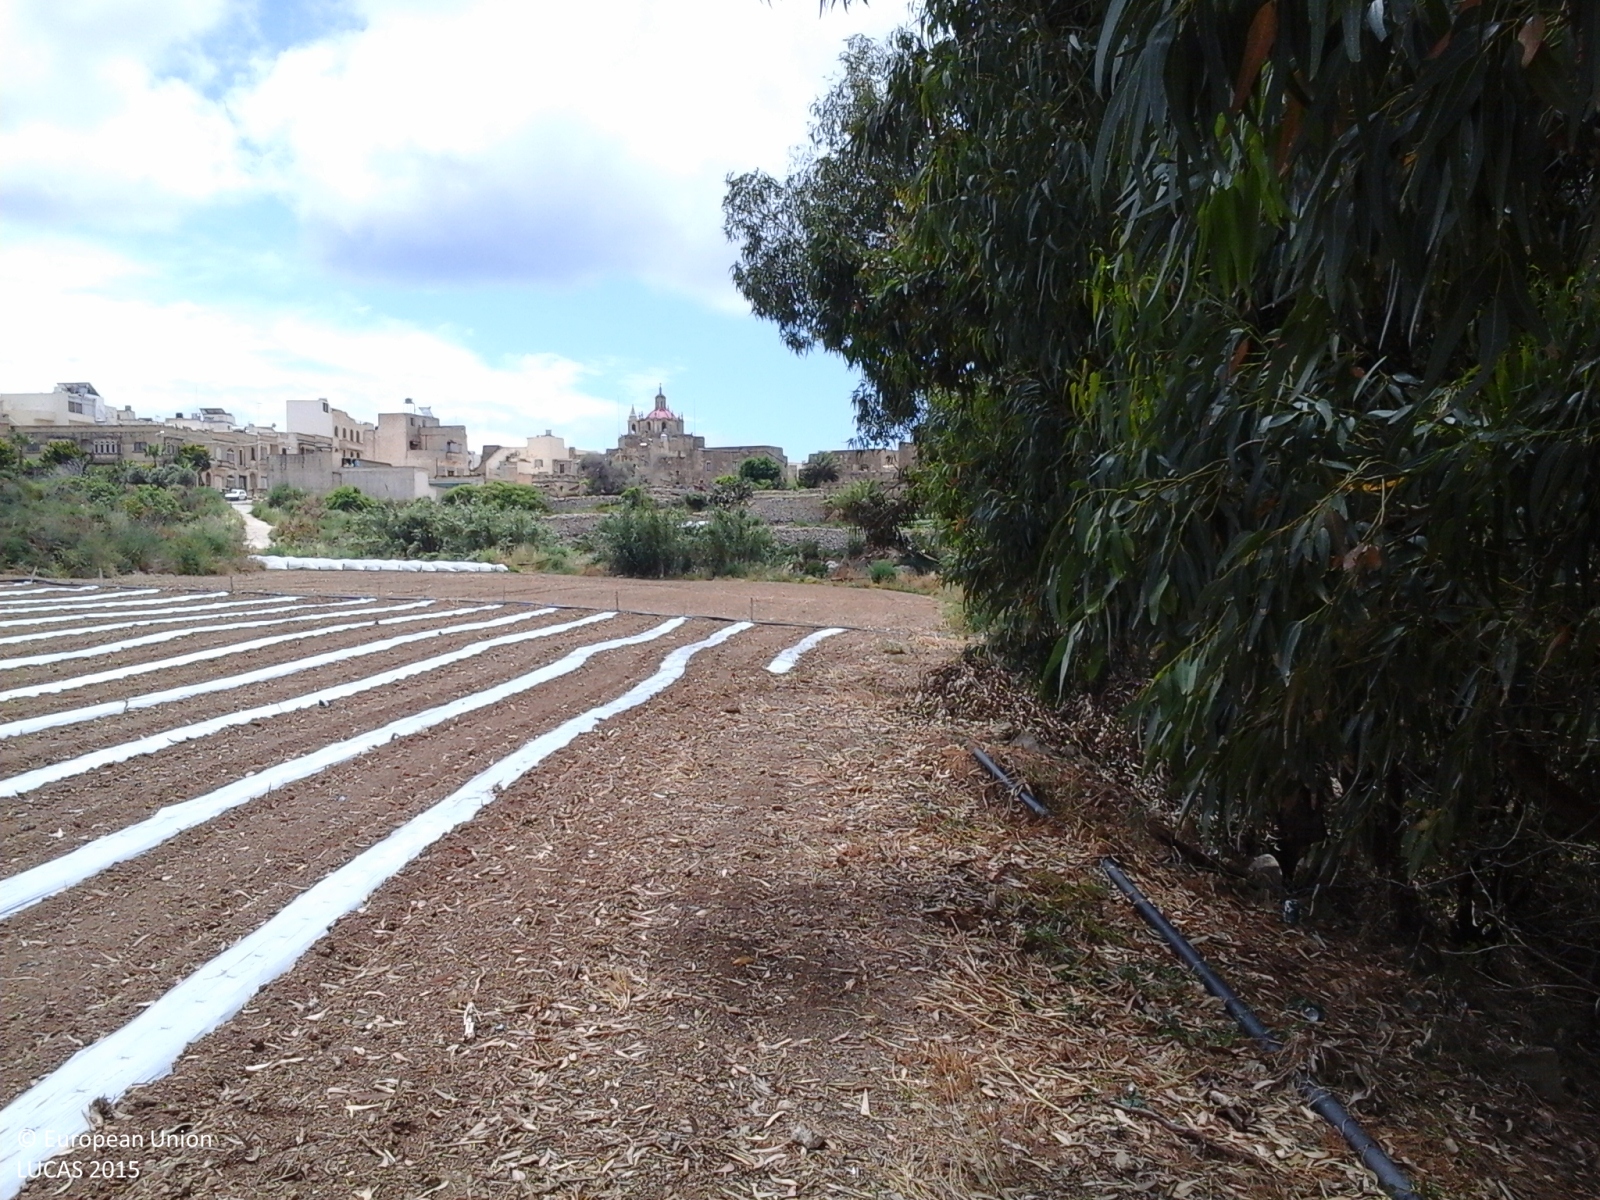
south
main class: Woodland
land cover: Broadleaved woodland
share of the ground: 50 - 75 %
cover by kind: broadleaved forest trees 55 %, herbaceous plants 45 %
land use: Semi-natural and natural areas not in use
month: May
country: MT
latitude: 36.0340
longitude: 14.2341
